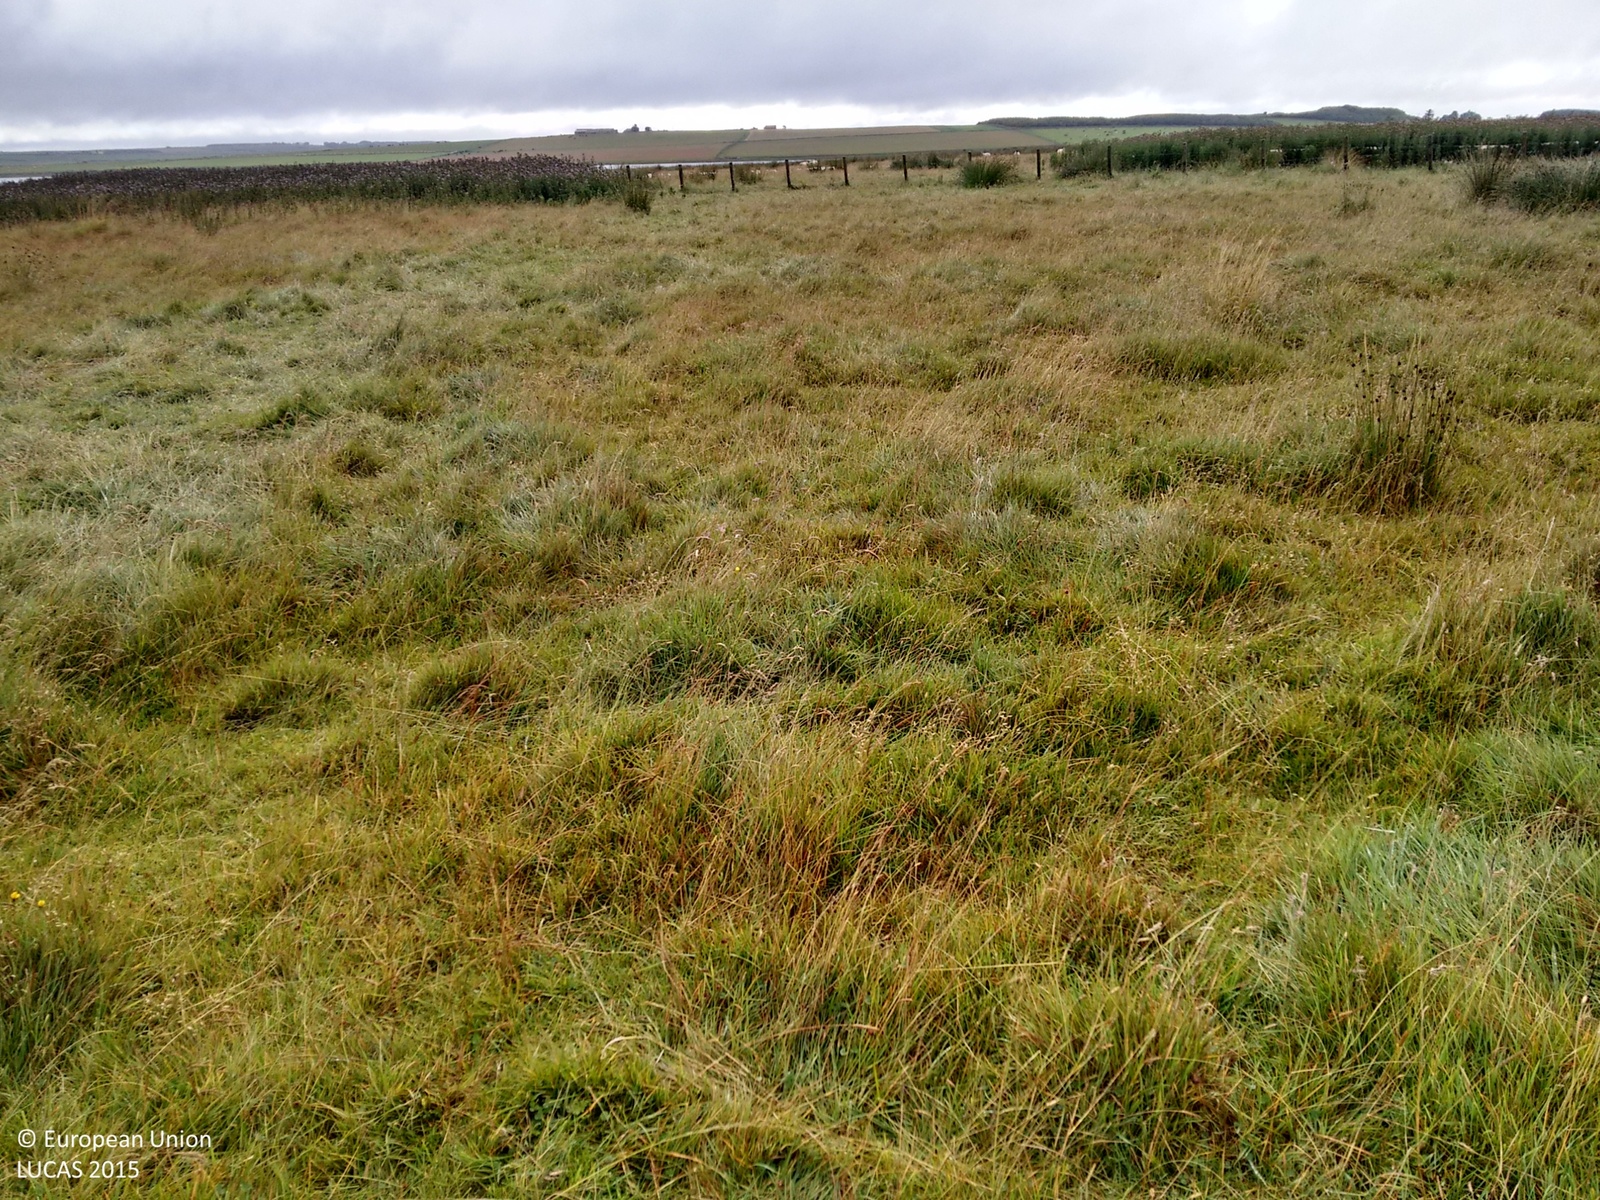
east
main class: Grassland
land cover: Grassland without tree/shrub cover
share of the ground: > 75 %
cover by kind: herbaceous plants 100 %
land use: Agriculture (excluding fallow land and kitchen gardens)
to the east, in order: Grassland without tree/shrub cover; Fences; Grassland without tree/shrub cover; Fences; Ditches and canals; Grassland without tree/shrub cover
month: September
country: GB
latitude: 58.5130
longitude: -3.4003
